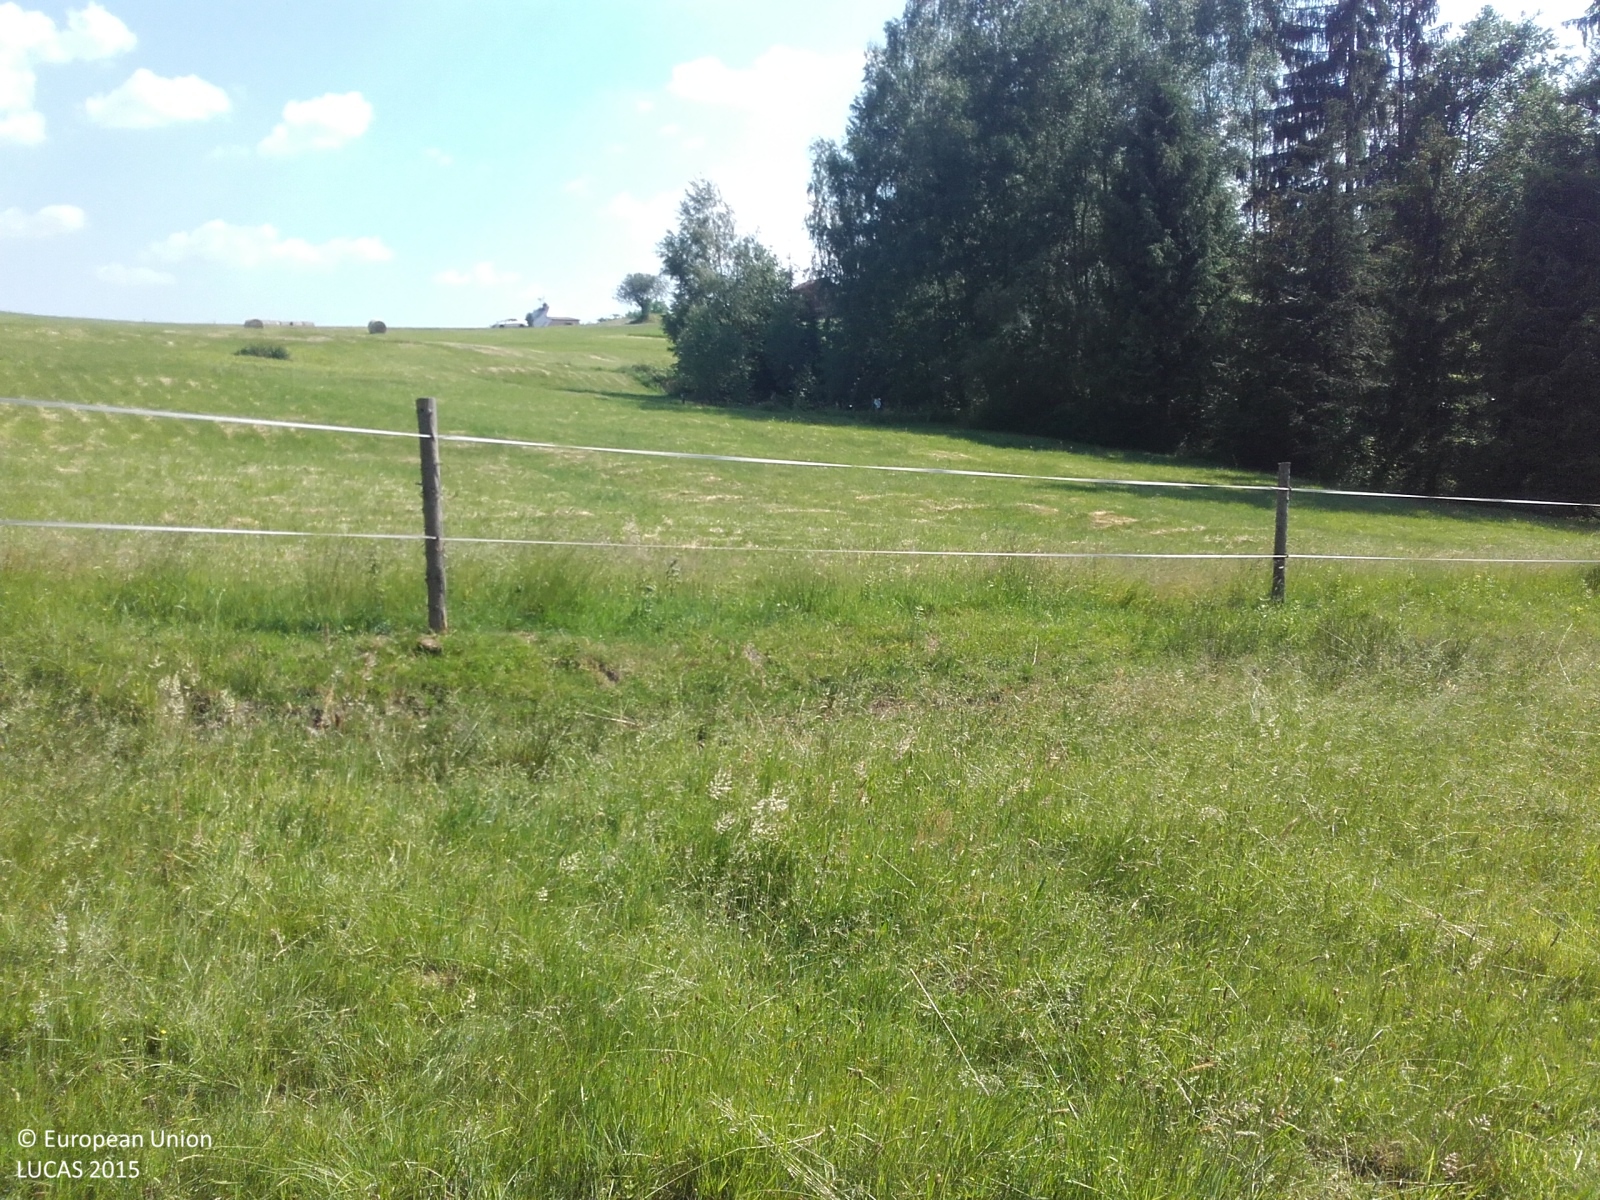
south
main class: Grassland
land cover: Grassland without tree/shrub cover
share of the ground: > 75 %
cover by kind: herbaceous plants 100 %
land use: Agriculture (excluding fallow land and kitchen gardens)
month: June
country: CZ
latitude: 49.5919
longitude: 18.7776
